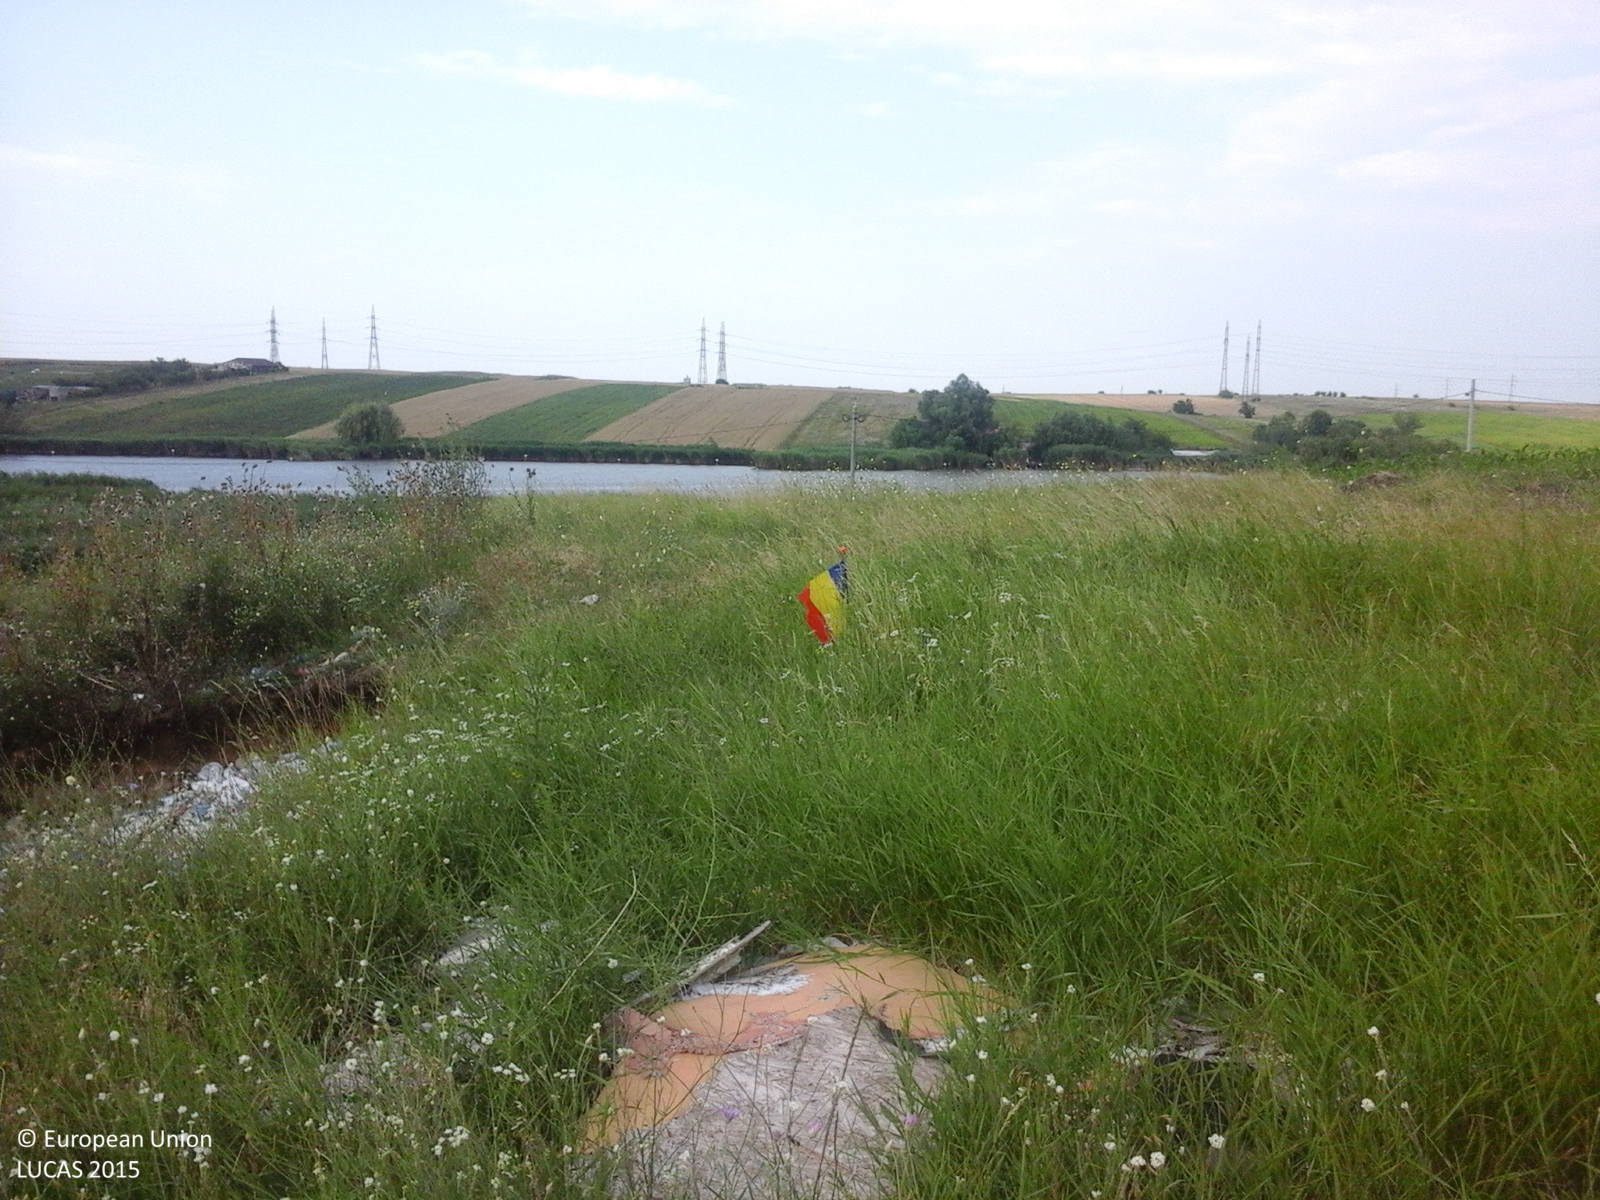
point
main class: Grassland
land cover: Spontaneously vegetated surfaces
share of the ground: > 75 %
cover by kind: herbaceous plants 100 %
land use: Fallow land
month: July
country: RO
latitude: 43.9385
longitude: 25.3184
